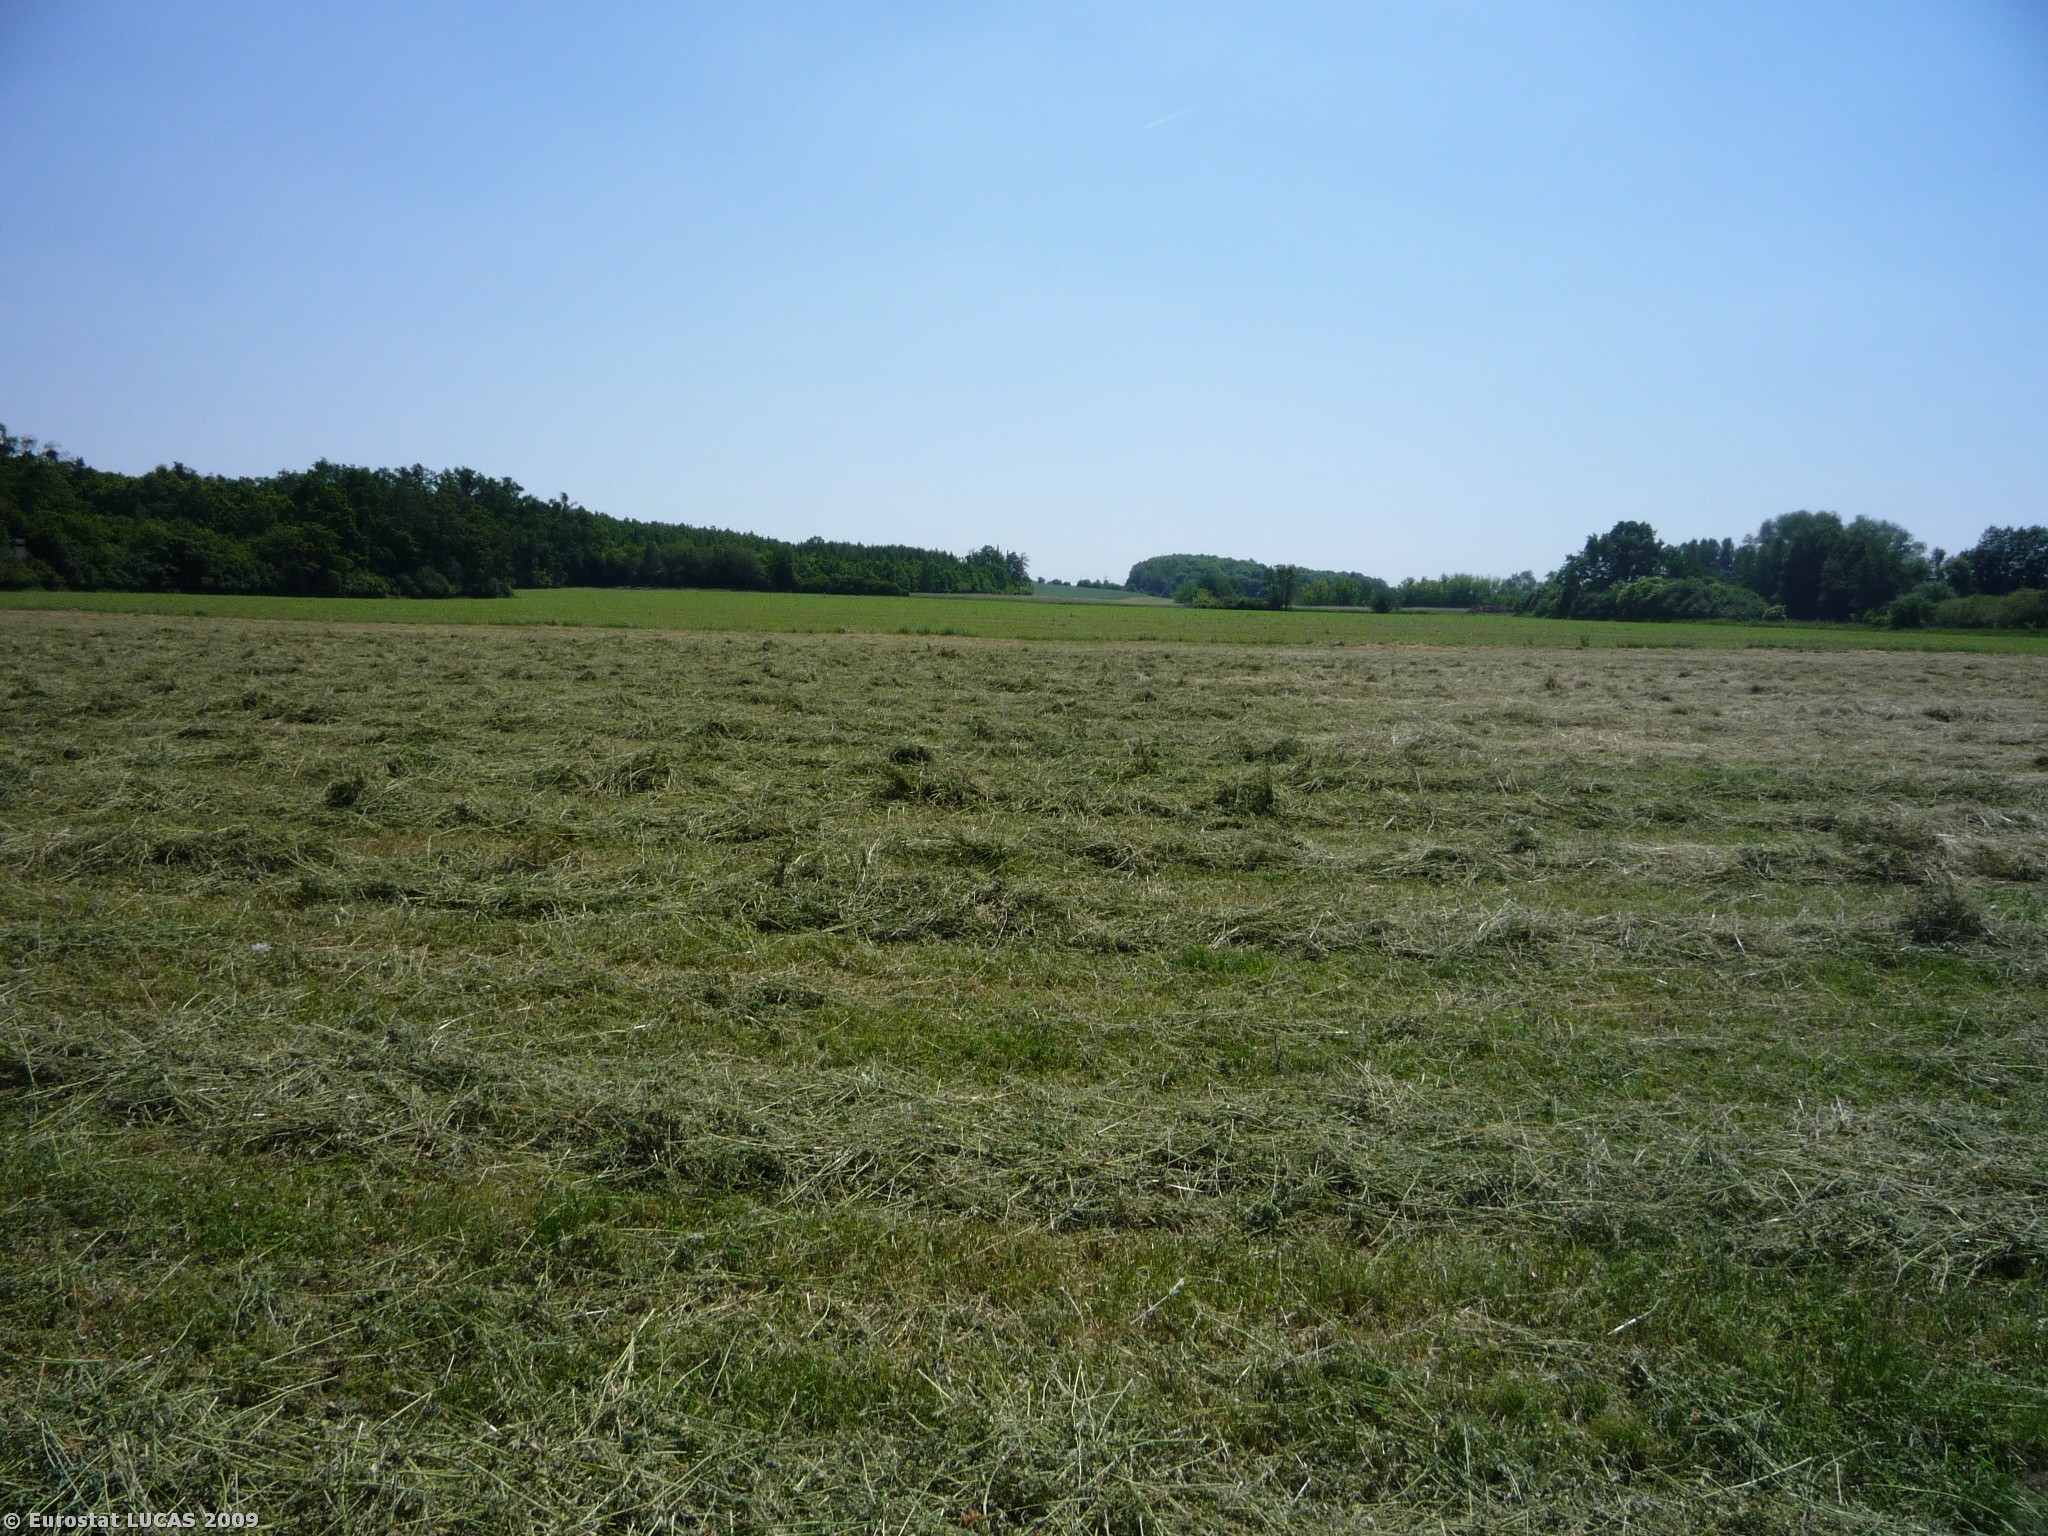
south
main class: Cropland
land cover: Lucerne
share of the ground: > 75 %
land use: Agriculture (excluding fallow land and kitchen gardens)
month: May
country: CZ
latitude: 50.2670
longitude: 15.5176
